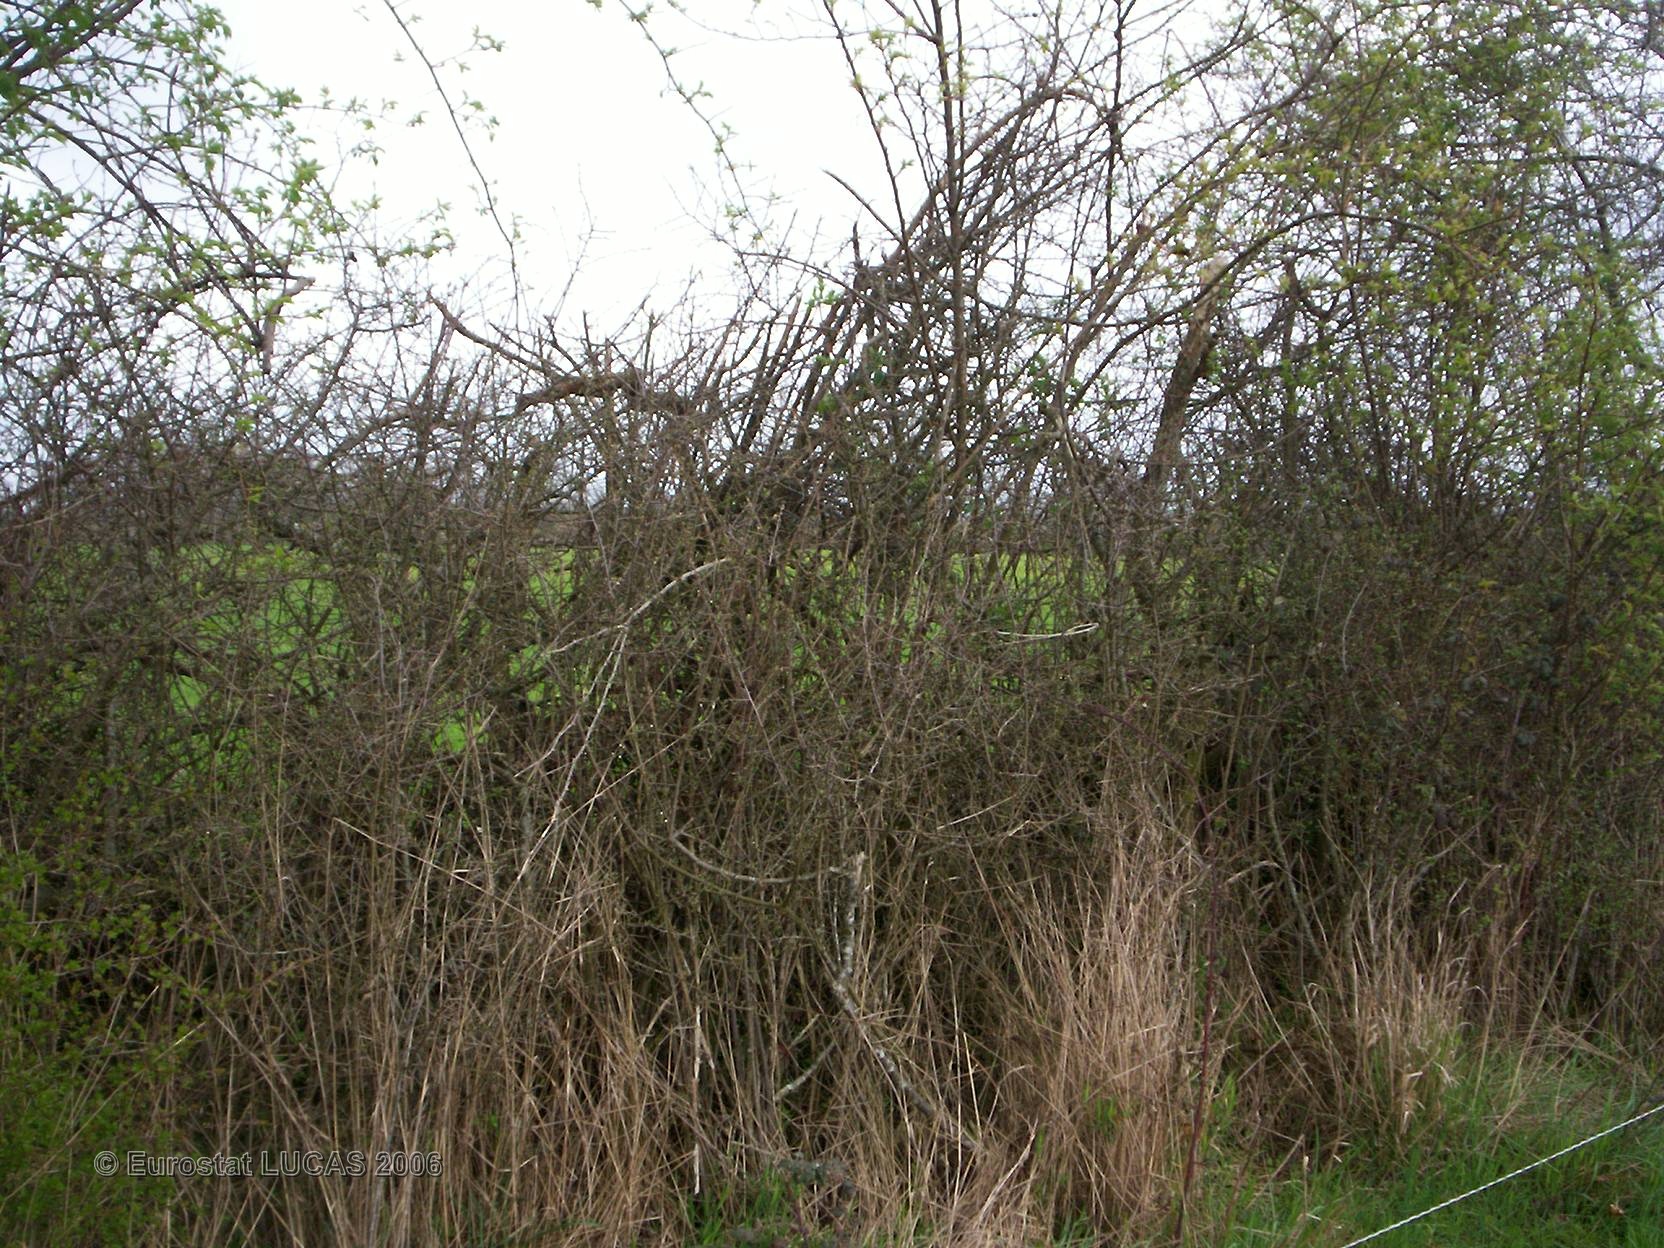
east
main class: Grassland
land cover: Grassland without tree/shrub cover
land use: Agriculture (excluding fallow land and kitchen gardens)
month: April
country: FR
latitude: 46.6984
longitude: 2.9736
